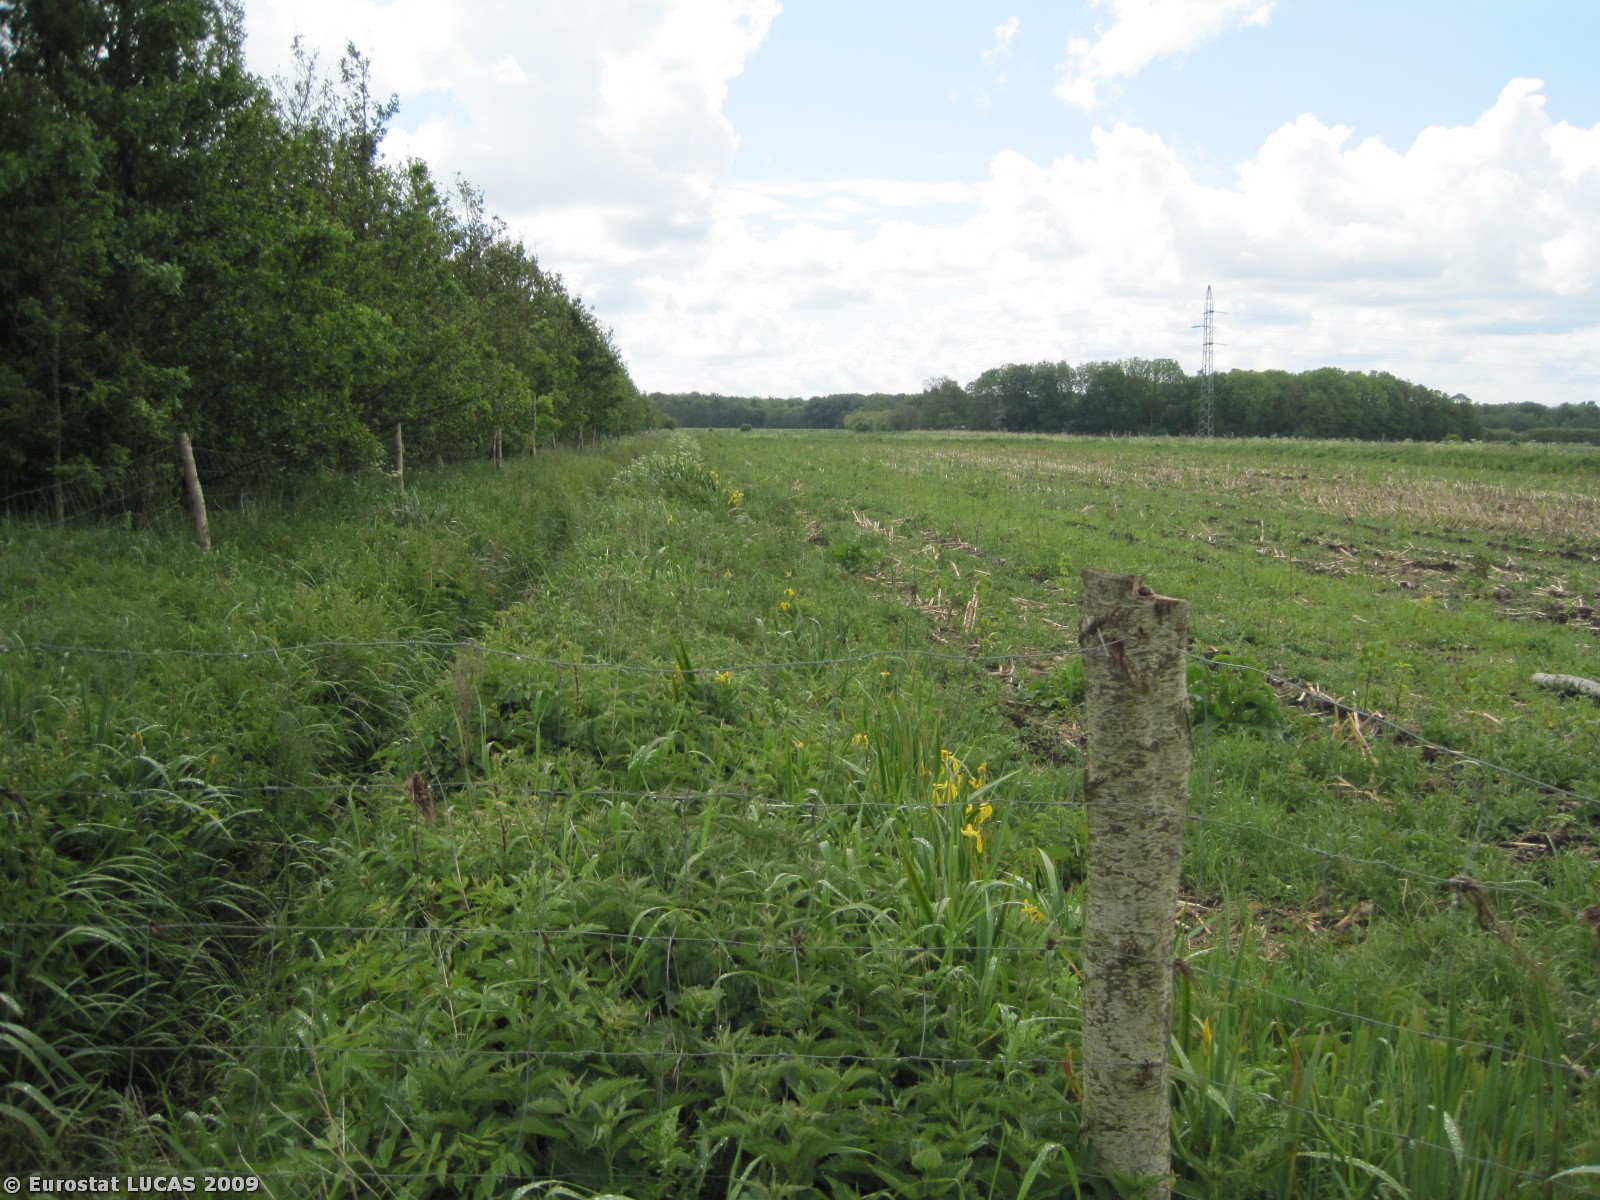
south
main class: Grassland
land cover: Grassland without tree/shrub cover
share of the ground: > 75 %
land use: Agriculture (excluding fallow land and kitchen gardens)
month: June
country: DK
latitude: 57.0503
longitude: 10.2798
